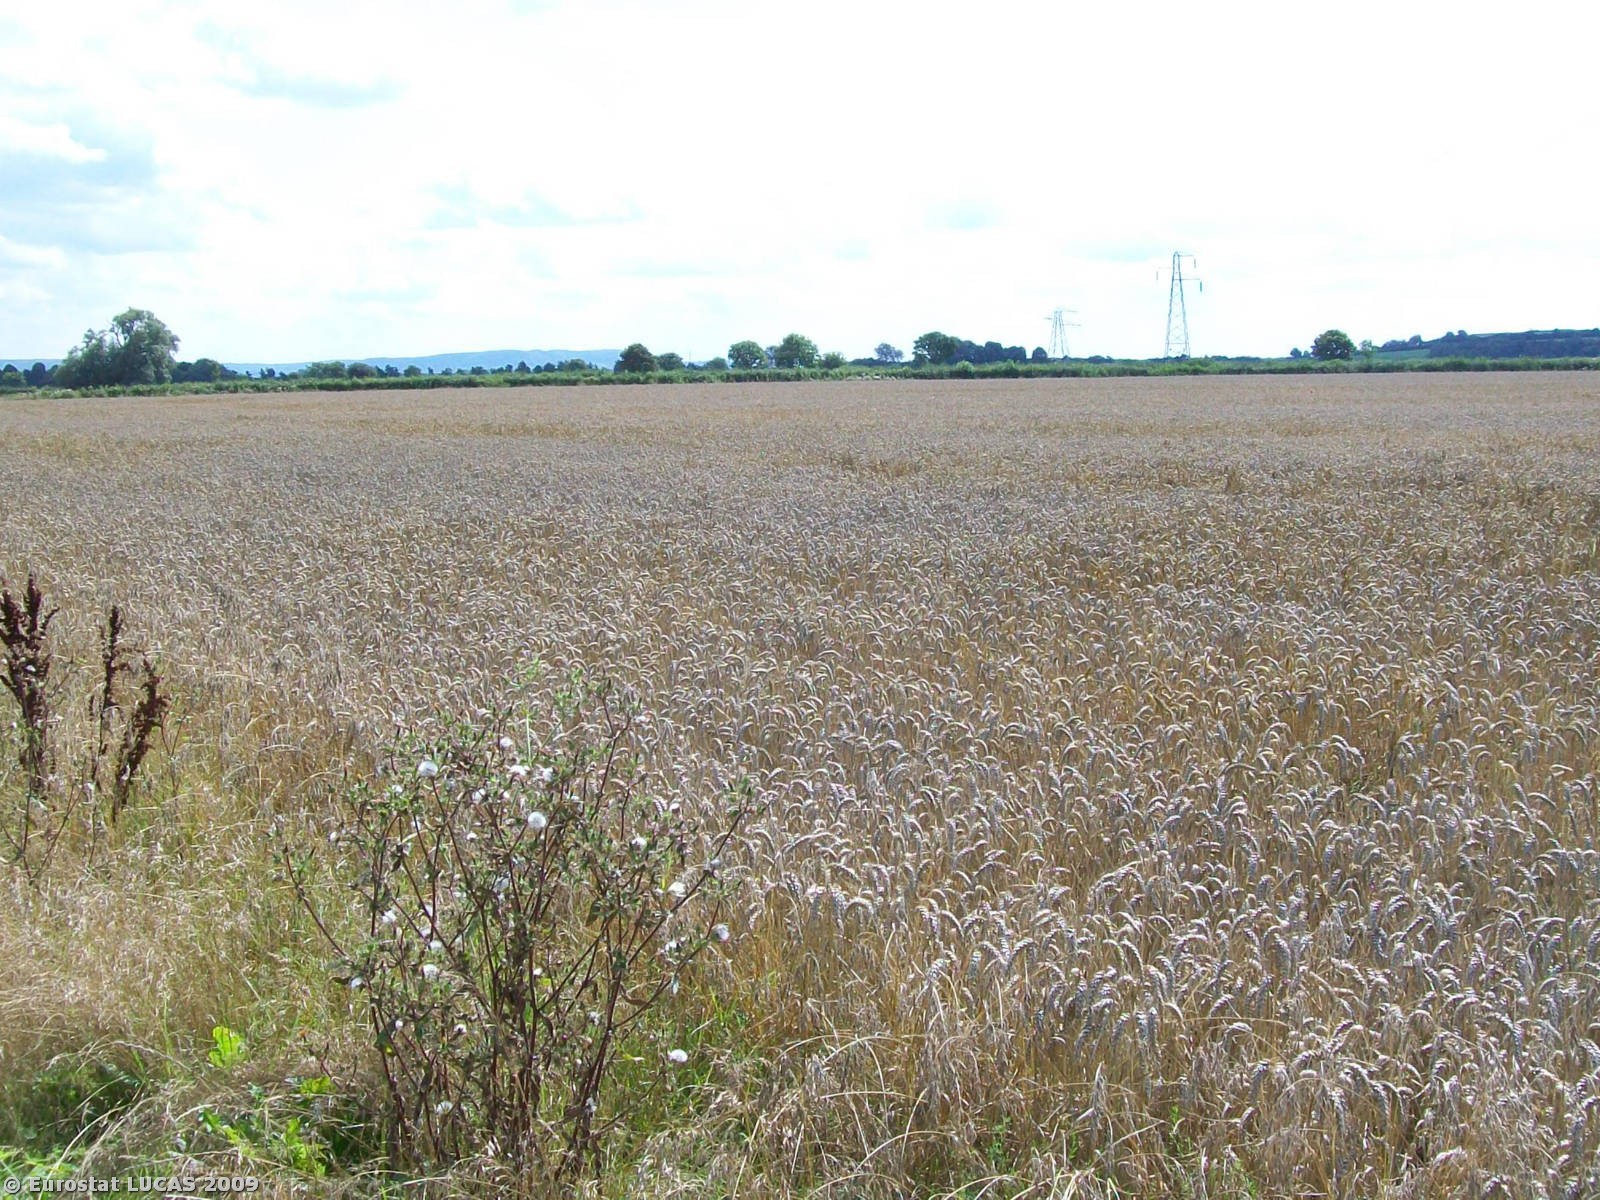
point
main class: Cropland
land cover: Common wheat
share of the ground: > 75 %
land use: Agriculture (excluding fallow land and kitchen gardens)
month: August
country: GB
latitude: 51.8203
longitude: -2.3520
